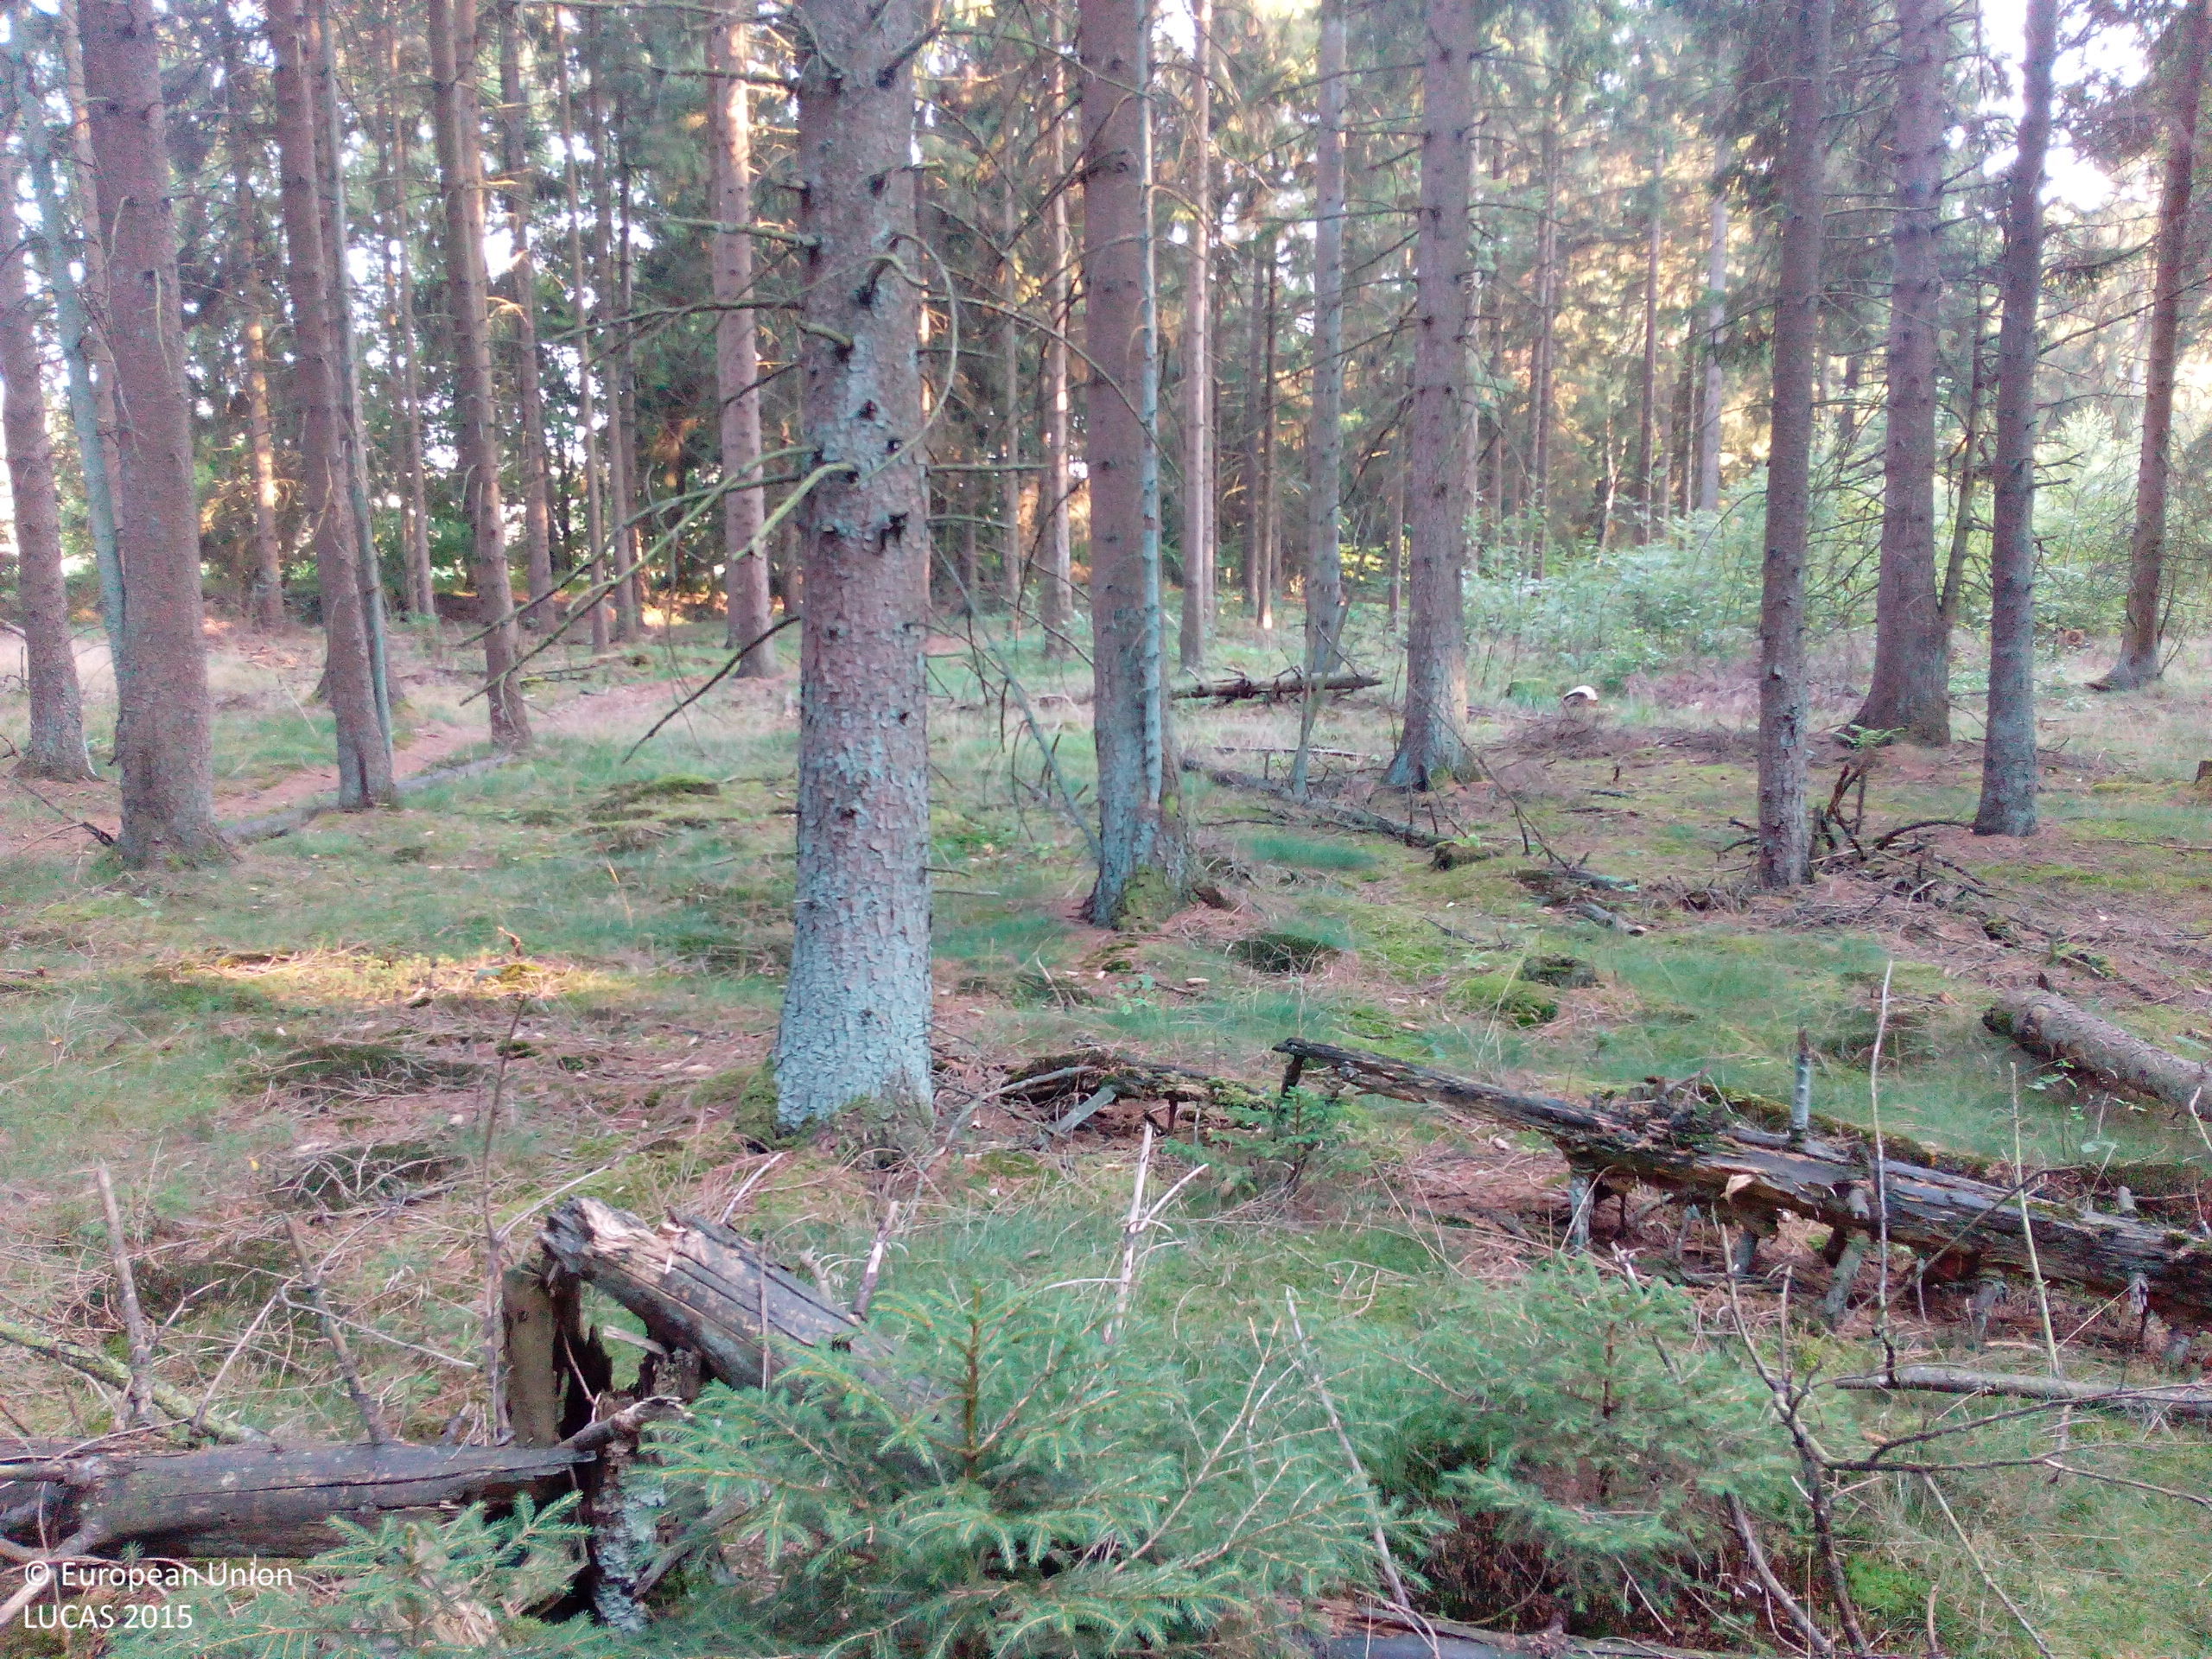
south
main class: Woodland
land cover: Spruce dominated coniferous woodland
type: hemiboreal forest and nemoral coniferous forest and mixed broadleaved-coniferous forest
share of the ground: > 75 %
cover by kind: coniferous forest trees 75 %, herbaceous plants 20 %, unconsolidated bare surface 5 %
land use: Forestry
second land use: Amenities, museums, leisure
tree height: > 5 m
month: August
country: DE
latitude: 53.8152
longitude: 9.8937
